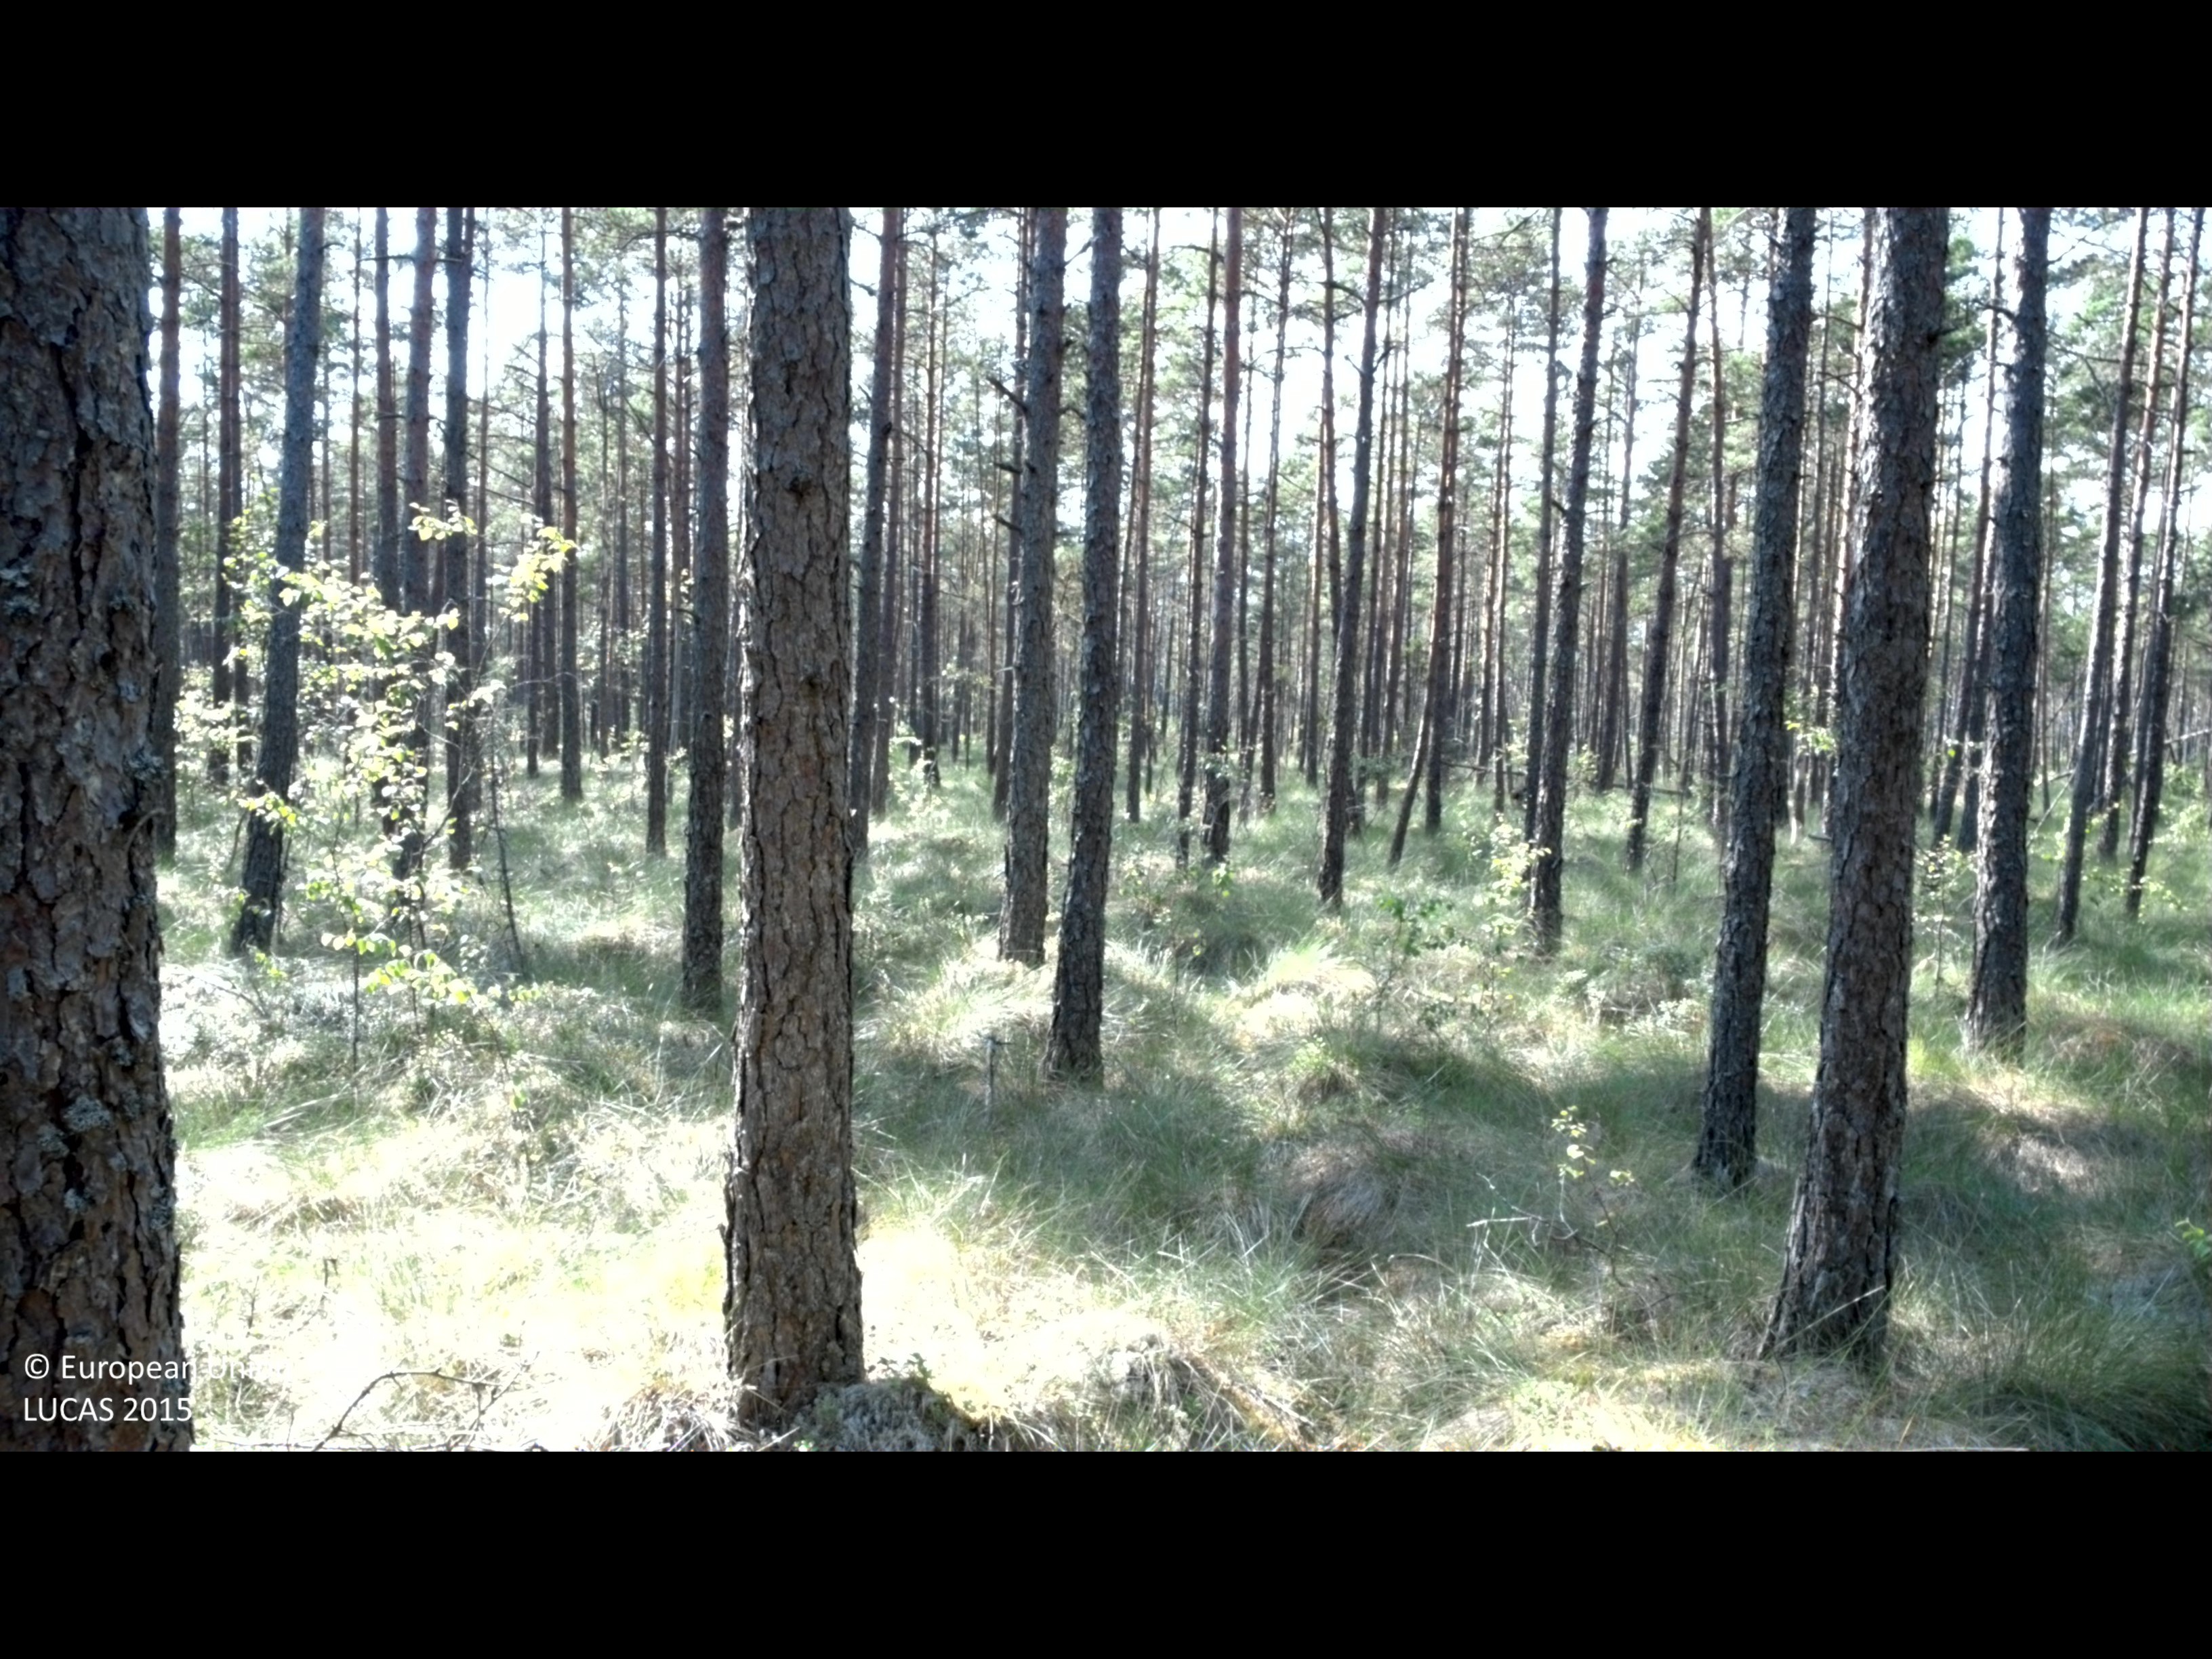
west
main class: Woodland
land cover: Pine dominated coniferous woodland
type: boreal forest
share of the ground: 50 - 75 %
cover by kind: coniferous forest trees 50 %, herbaceous plants 25 %, shrubs 20 %, broadleaved forest trees 5 %
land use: Forestry
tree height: > 5 m
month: August
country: SE
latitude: 56.6816
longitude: 14.0614
